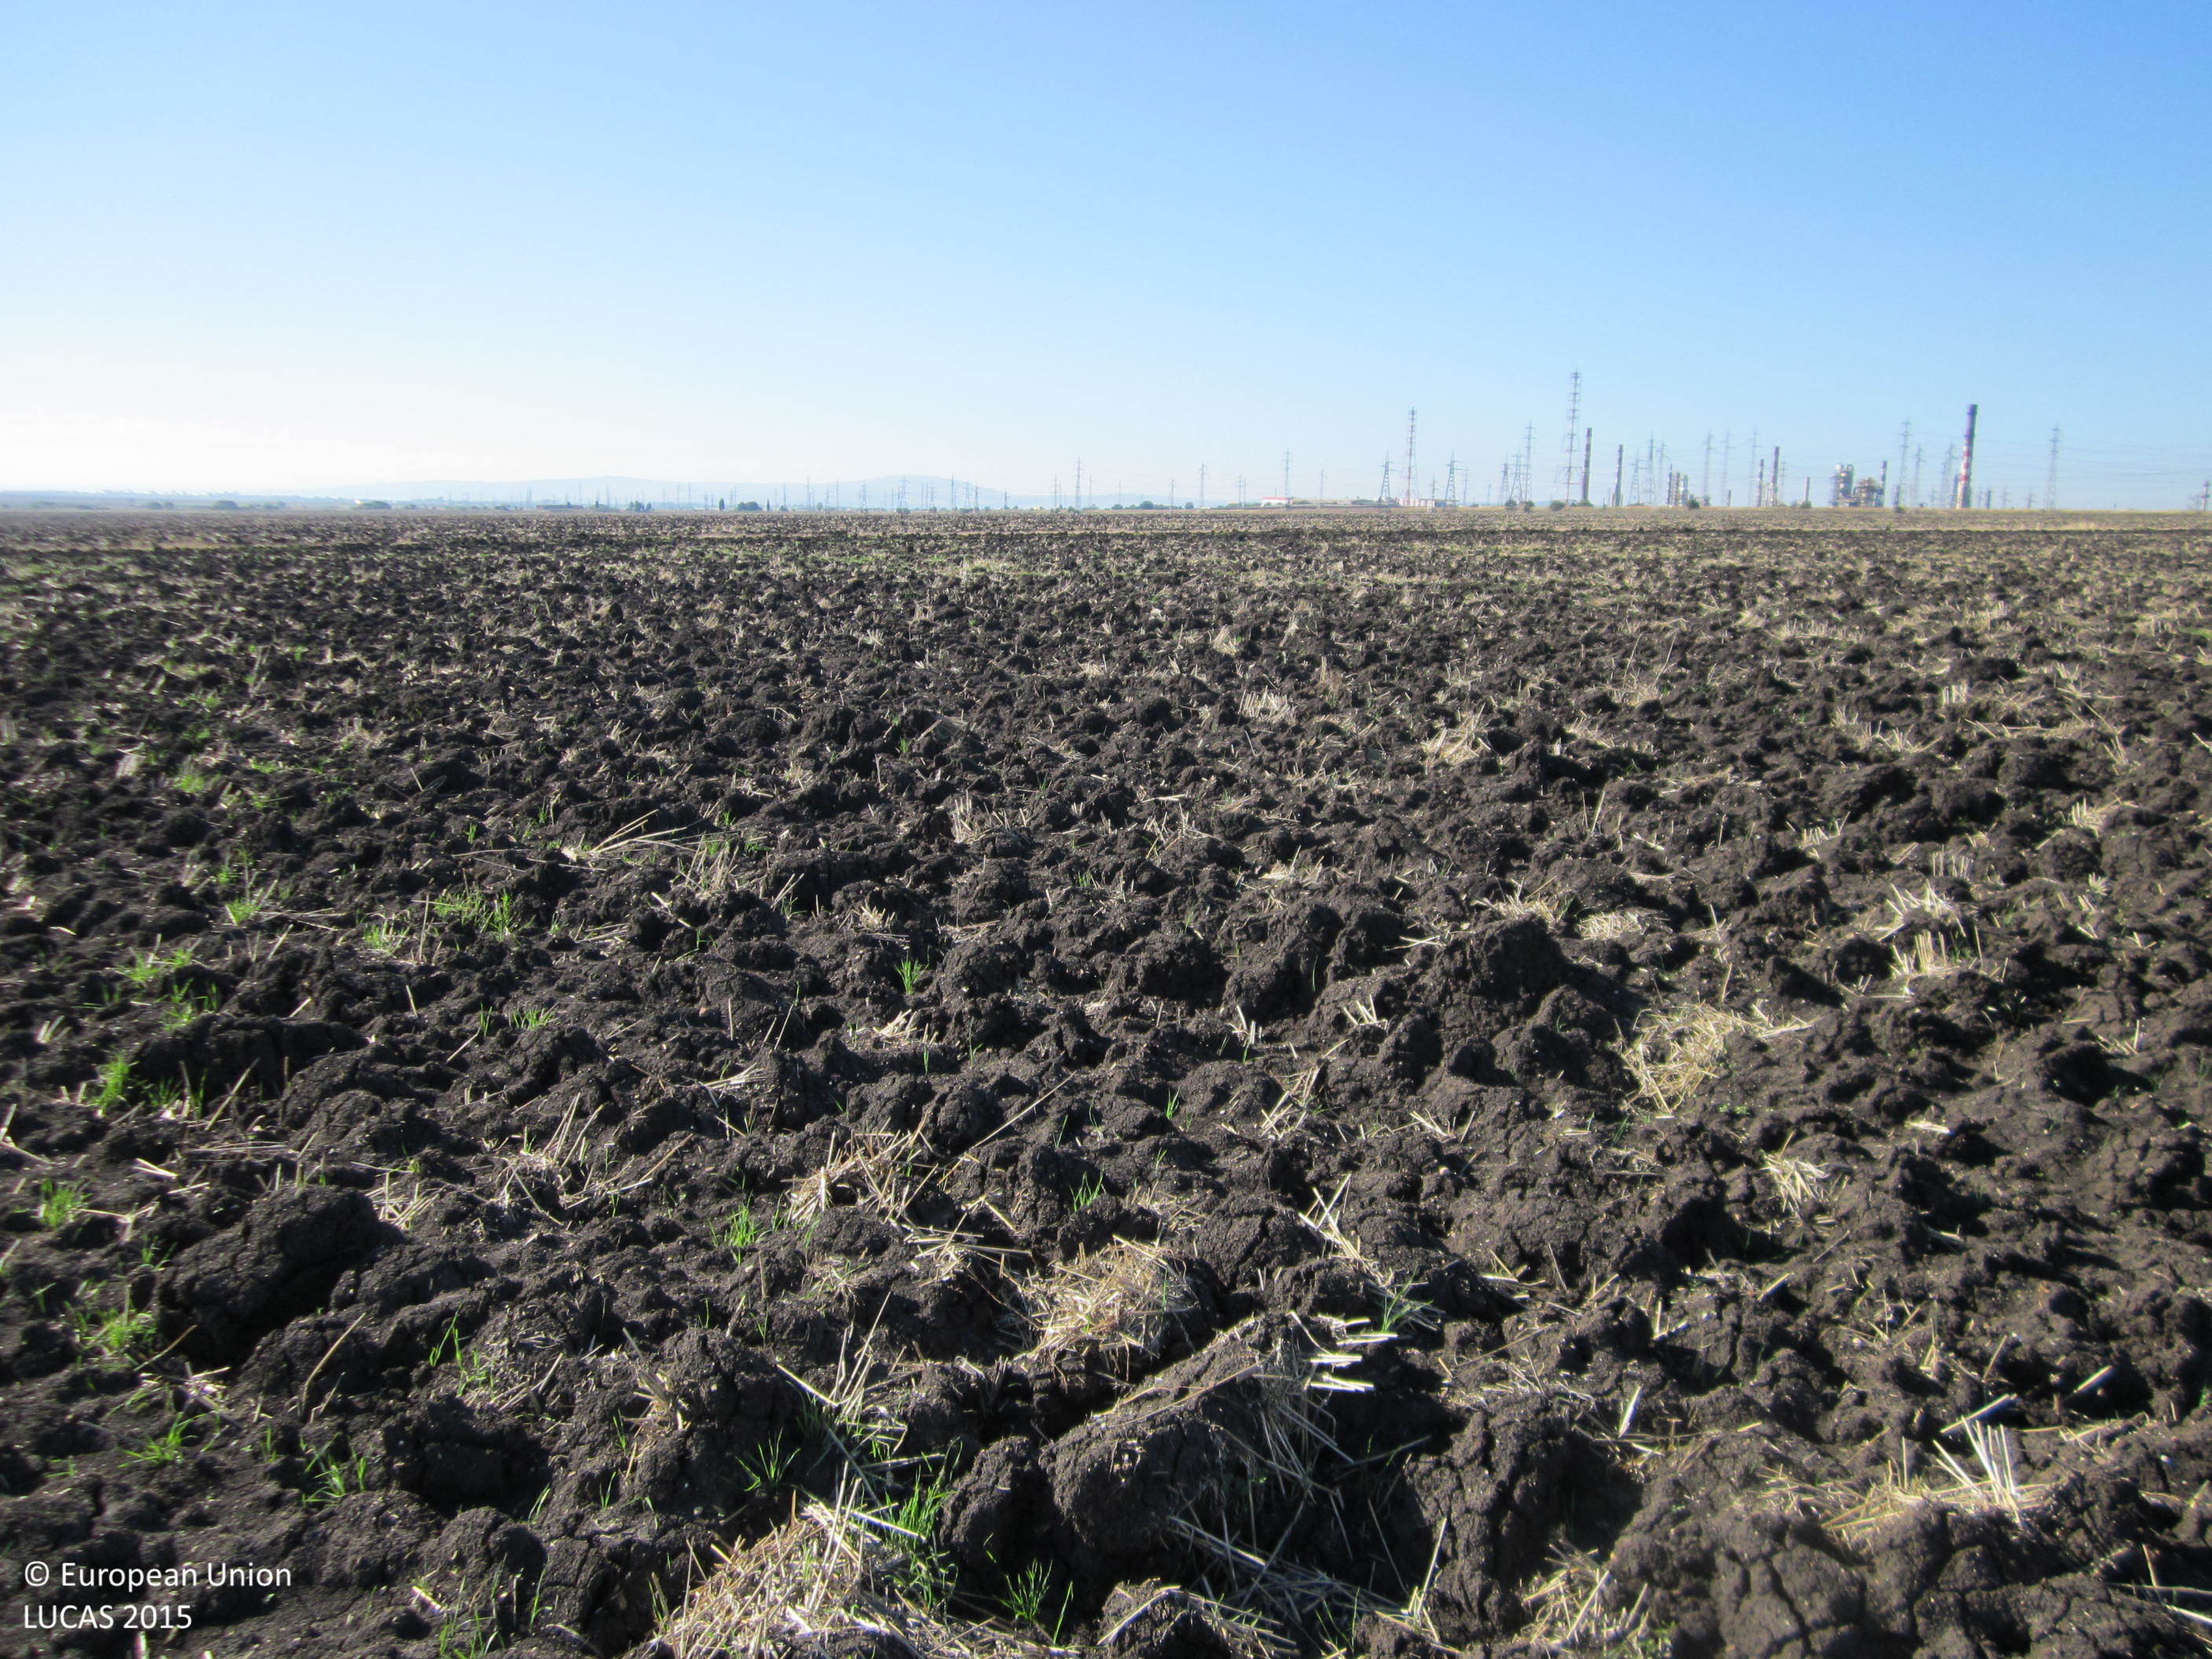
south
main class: Cropland
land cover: Common wheat
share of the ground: < 10 %
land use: Agriculture (excluding fallow land and kitchen gardens)
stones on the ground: < 10 %
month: September
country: BG
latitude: 42.5621
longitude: 27.3501
